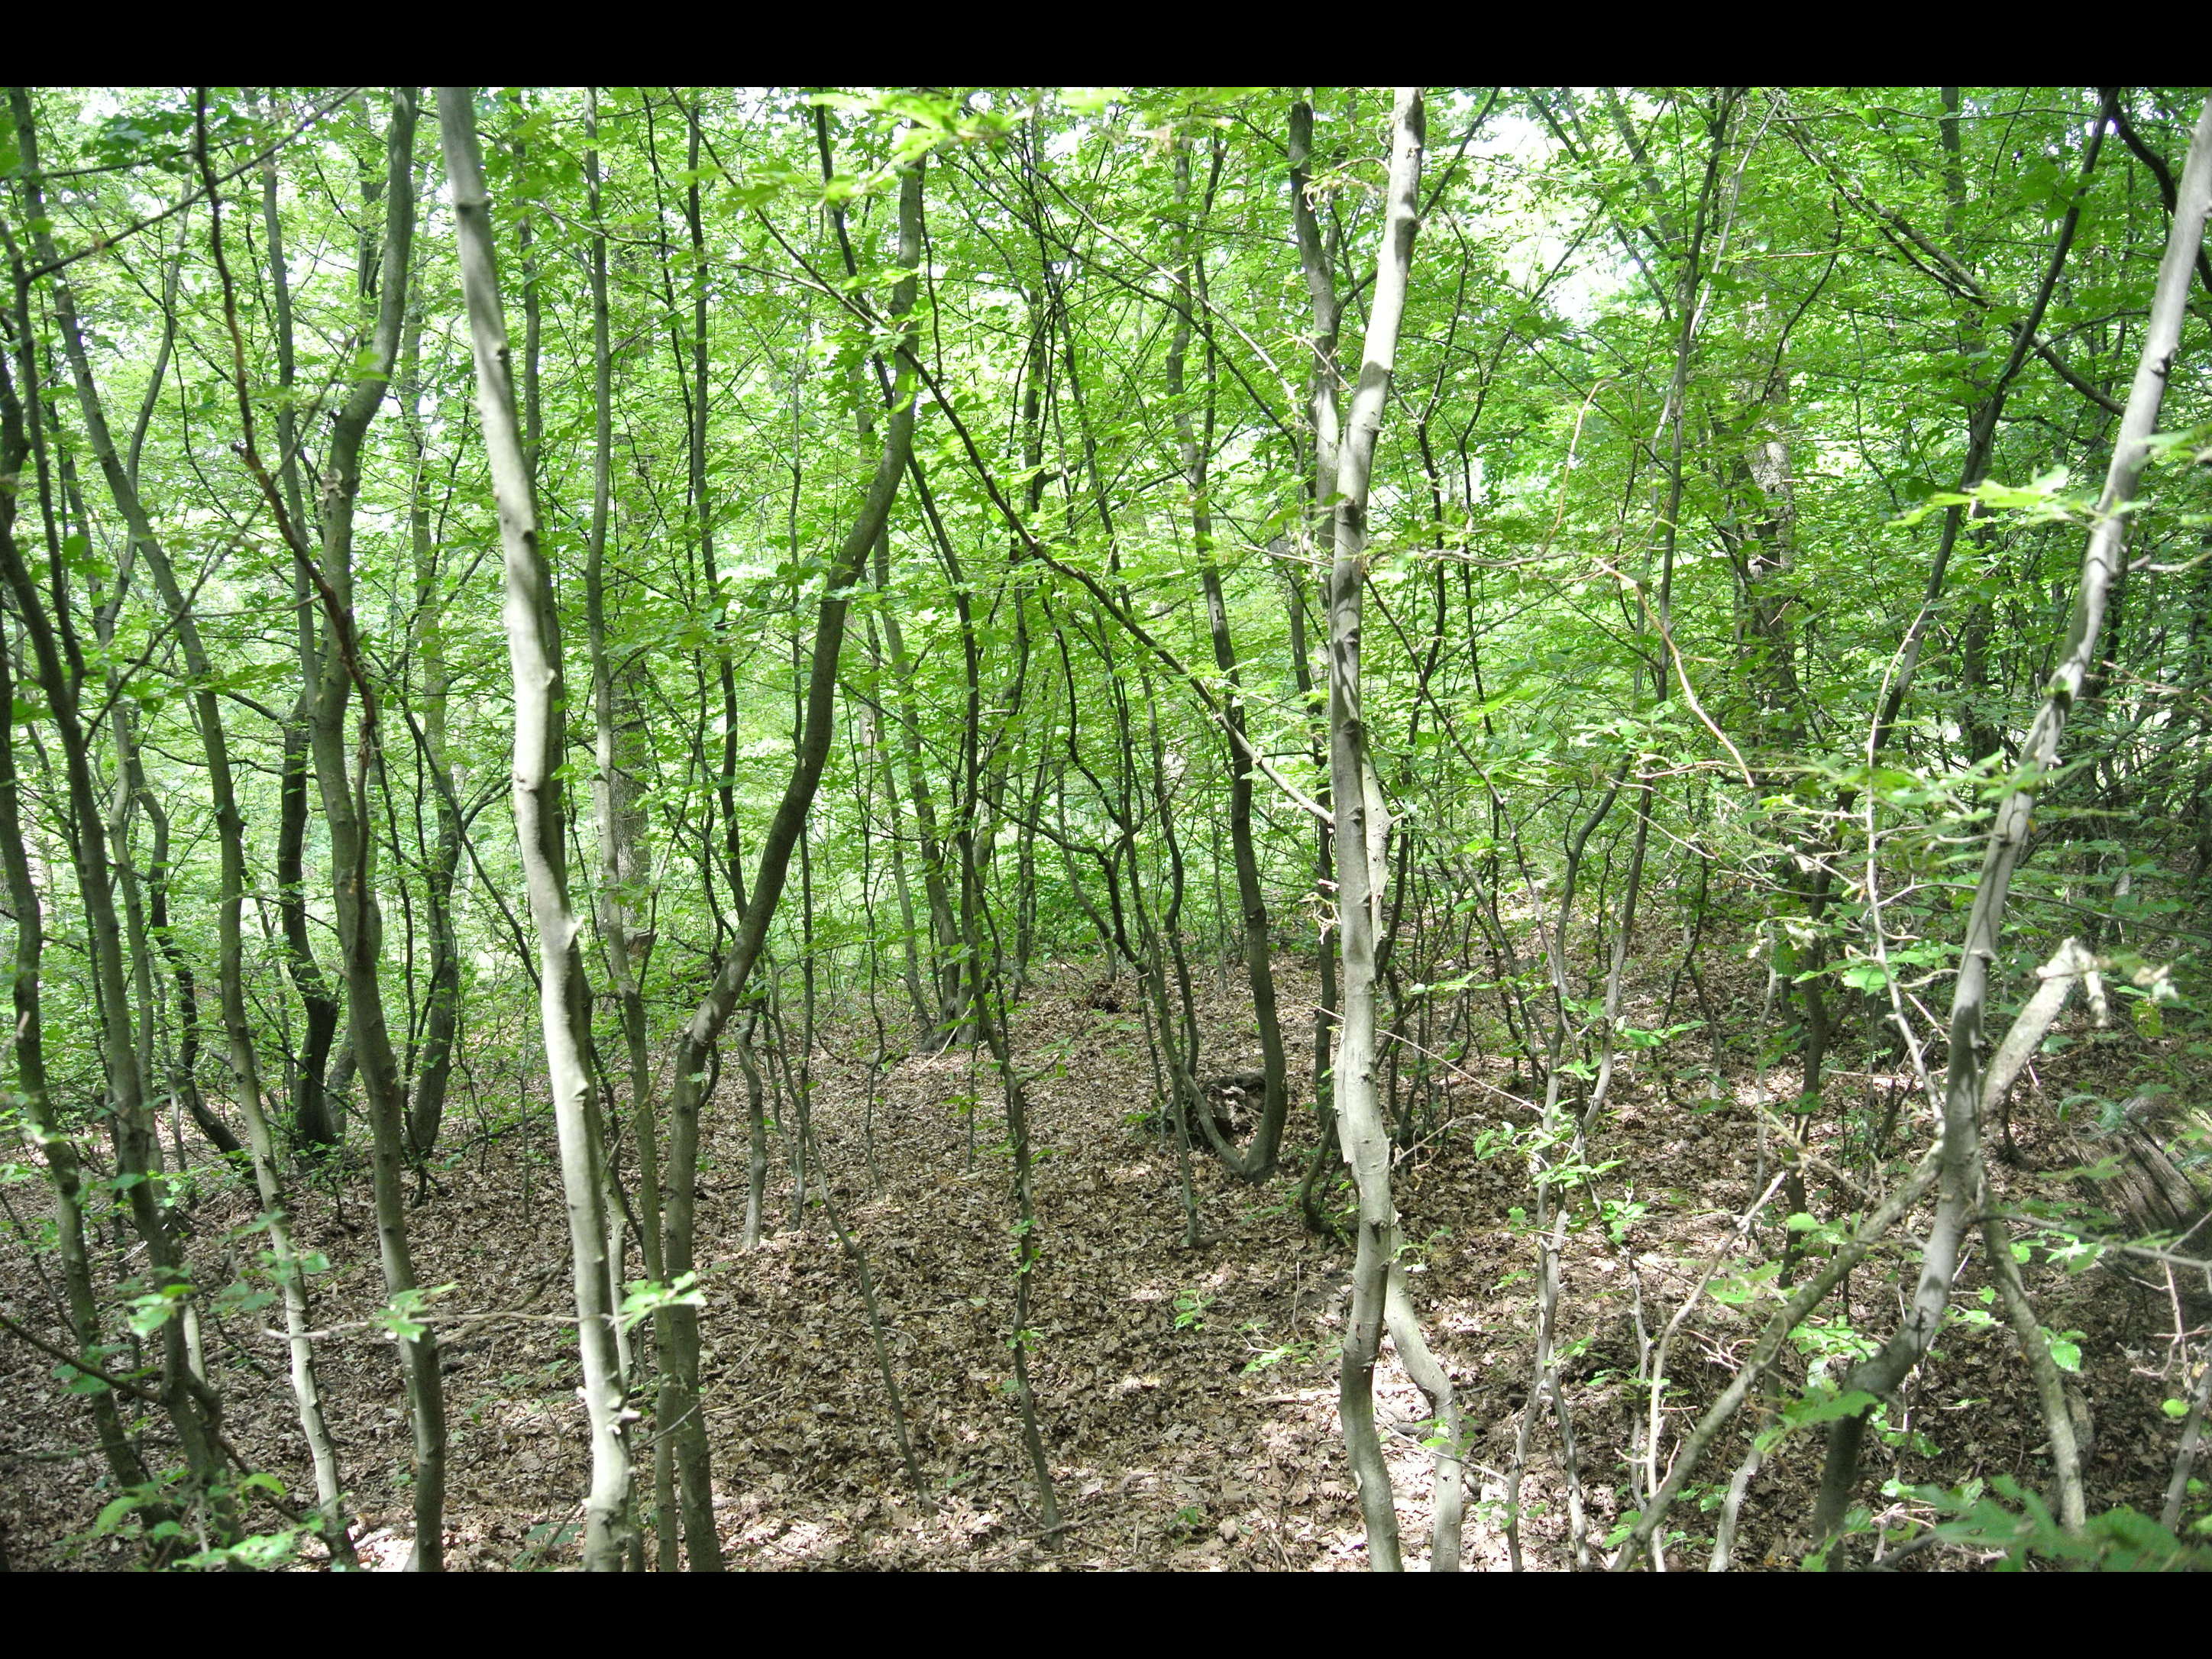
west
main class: Woodland
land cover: Broadleaved woodland
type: beech forest
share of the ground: > 75 %
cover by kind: broadleaved forest trees 95 %, unconsolidated bare surface 5 %
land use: Forestry
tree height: > 5 m
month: June
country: AT
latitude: 47.8993
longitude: 16.5999
